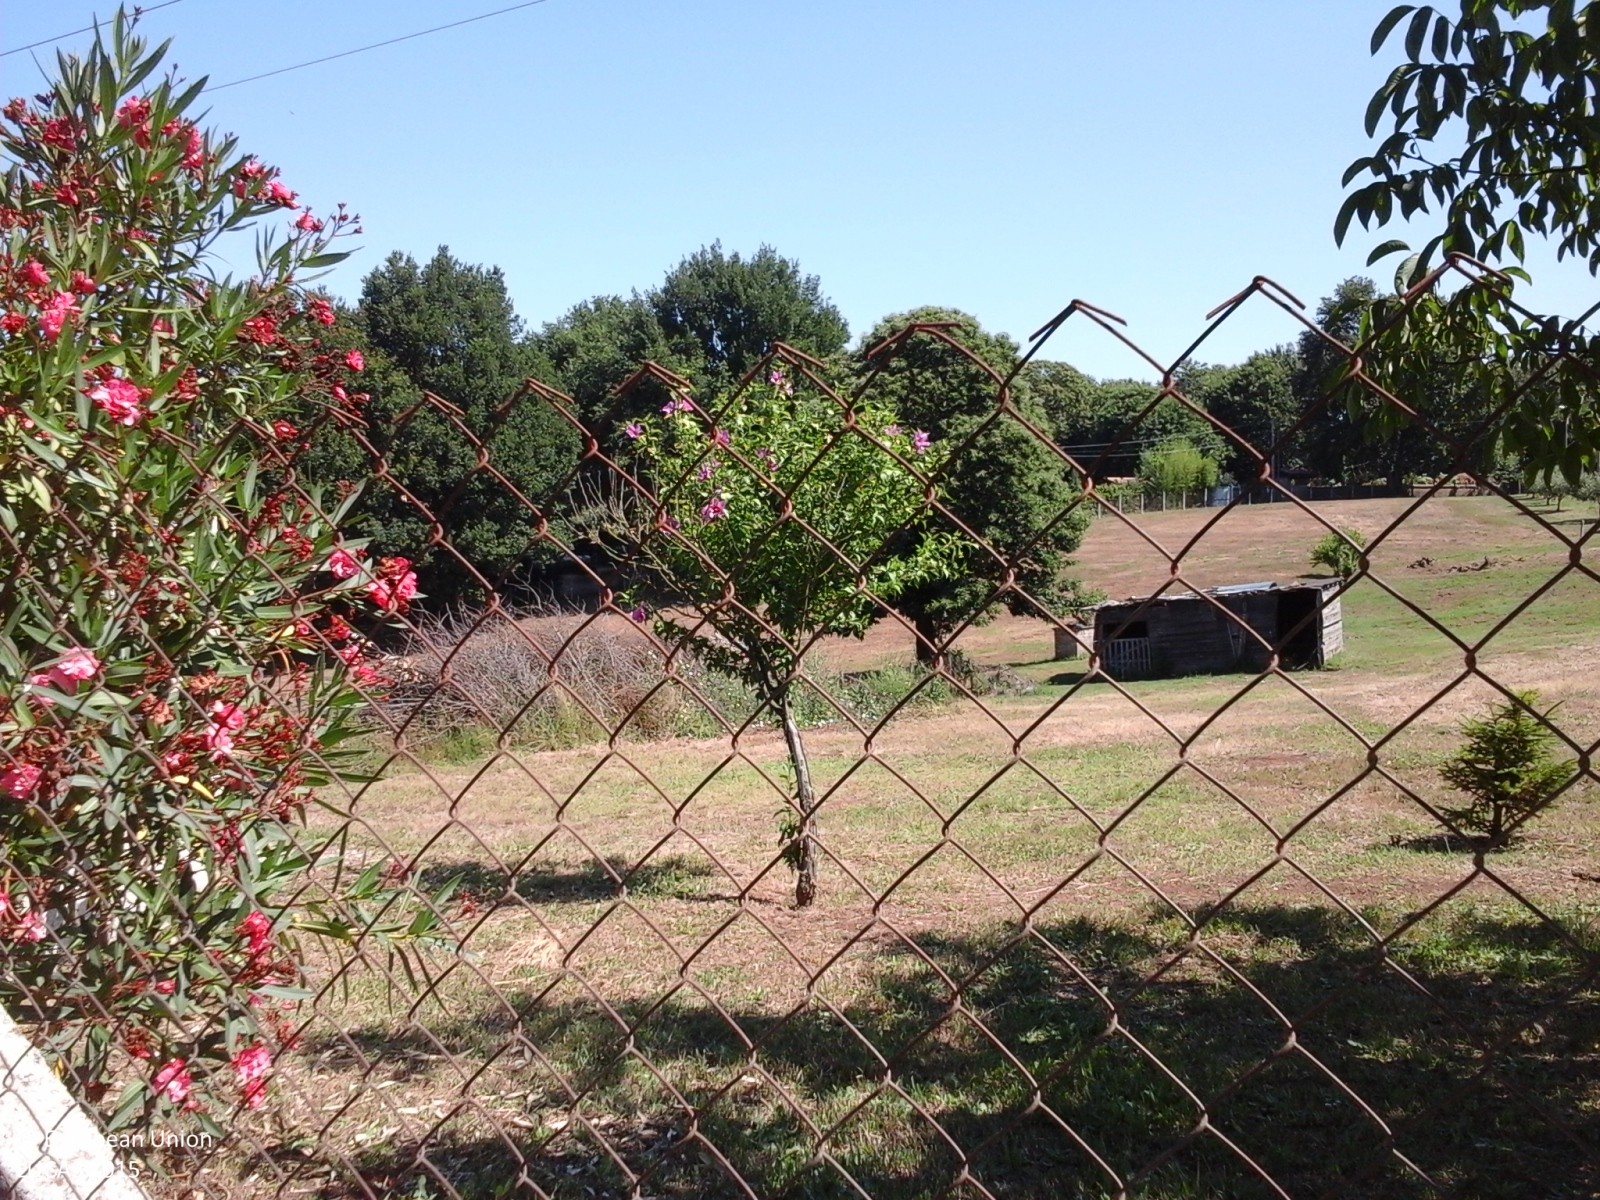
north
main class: Grassland
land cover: Grassland without tree/shrub cover
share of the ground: > 75 %
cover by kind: herbaceous plants 100 %
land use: Agriculture (excluding fallow land and kitchen gardens)
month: July
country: IT
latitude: 41.8188
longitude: 12.8425
